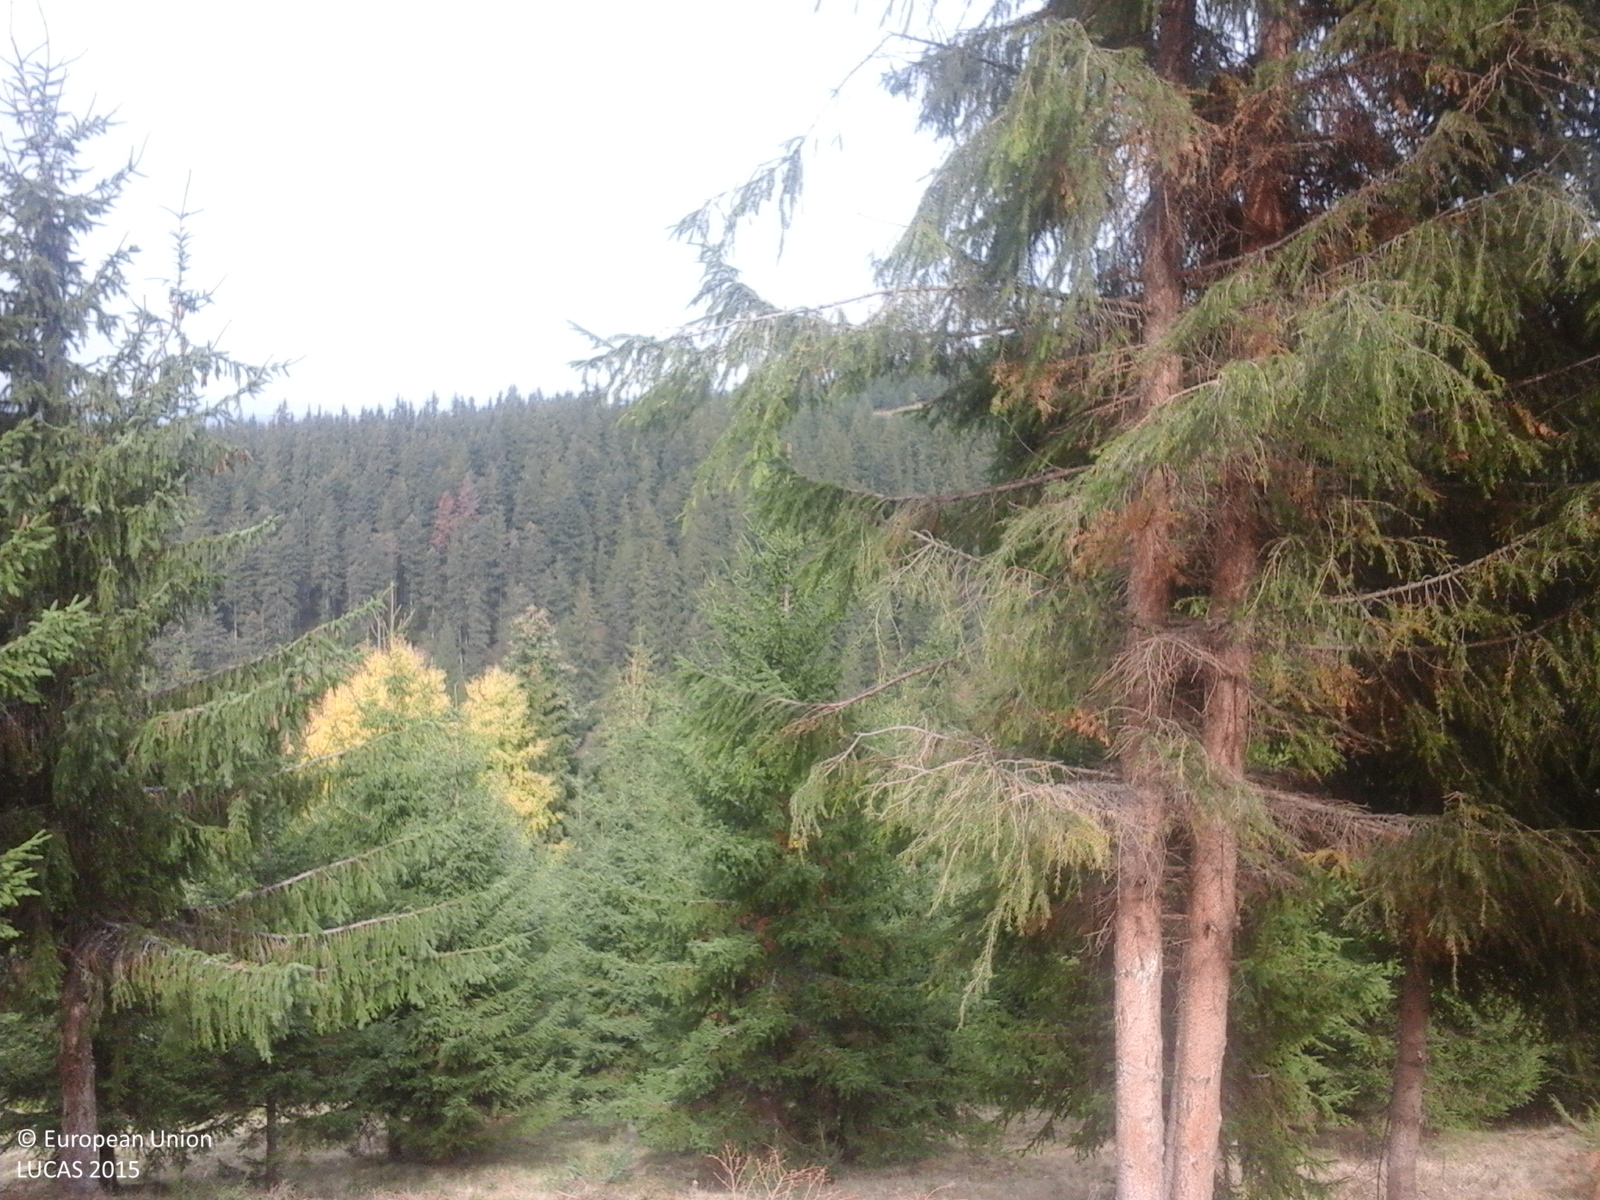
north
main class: Grassland
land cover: Grassland with sparse tree/shrub cover
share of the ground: > 75 %
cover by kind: herbaceous plants 85 %, shrubs 10 %, broadleaved forest trees 5 %
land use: Fallow land
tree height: > 5 m
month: October
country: RO
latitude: 46.4957
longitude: 25.8701
